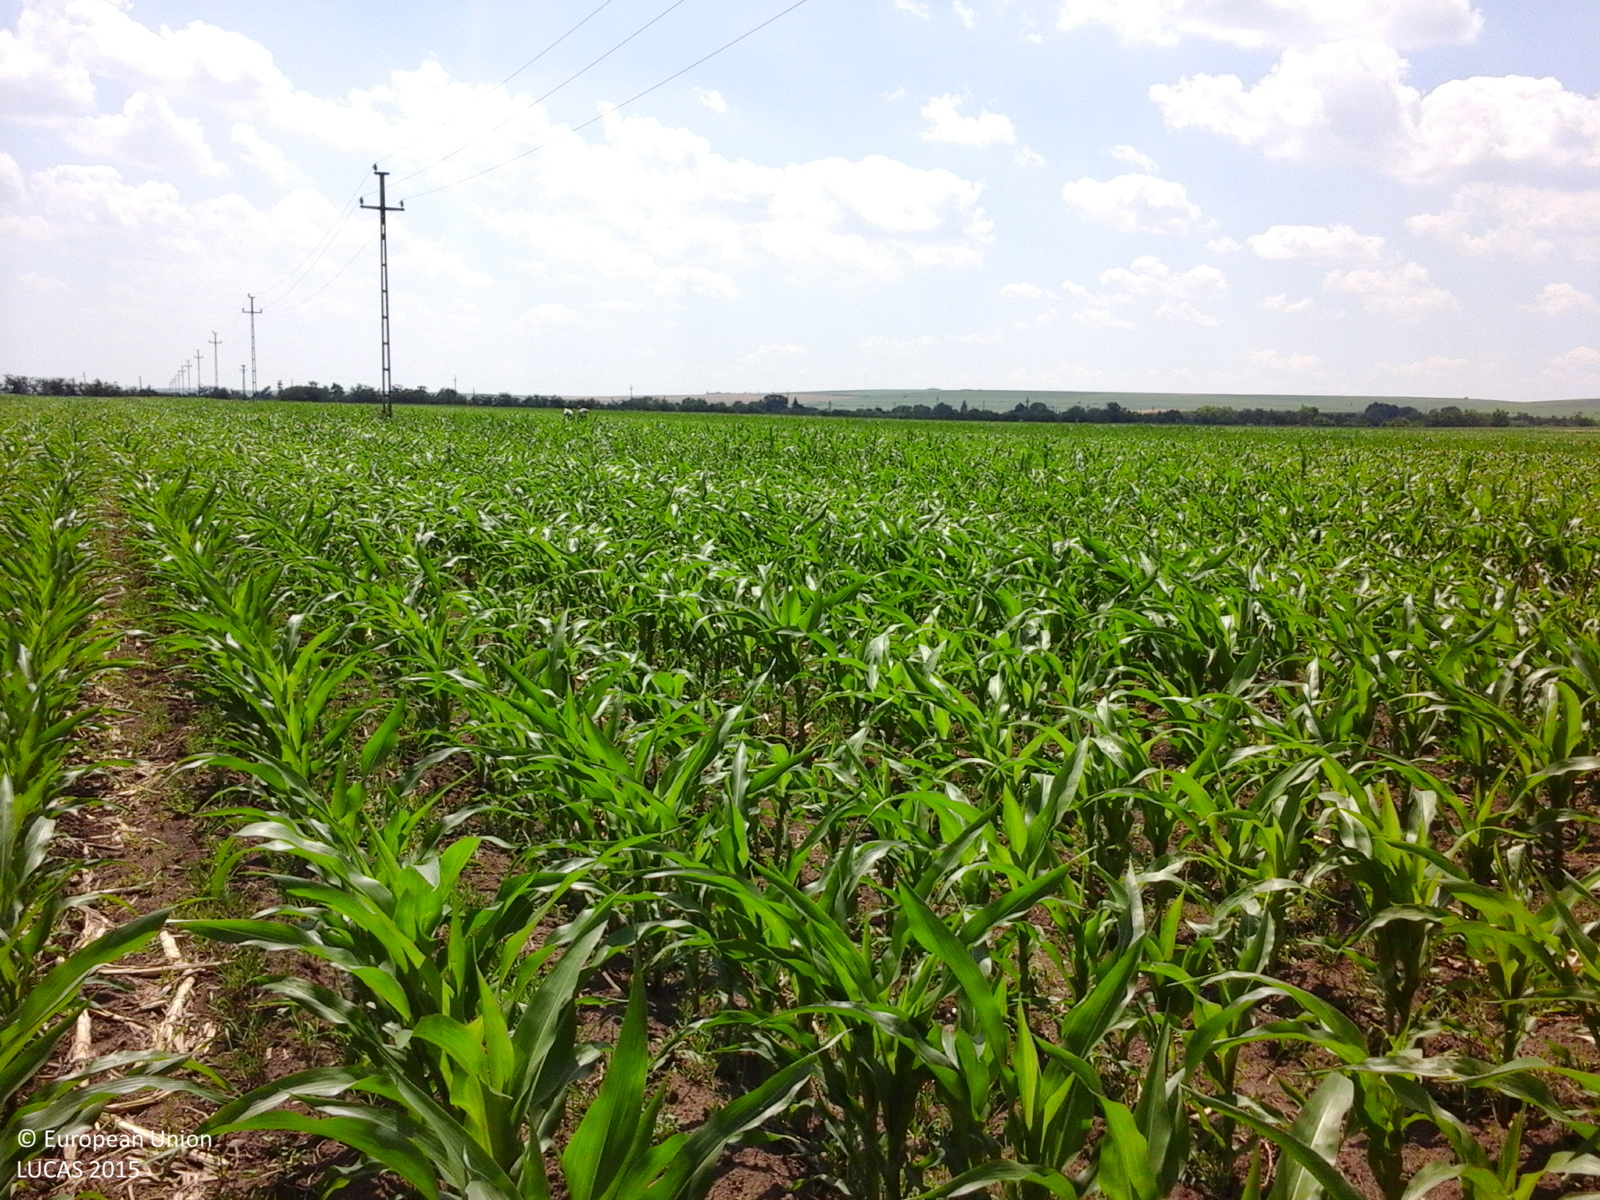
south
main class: Cropland
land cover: Maize
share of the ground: 50 - 75 %
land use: Agriculture (excluding fallow land and kitchen gardens)
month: June
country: RO
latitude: 47.5605
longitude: 27.4067
